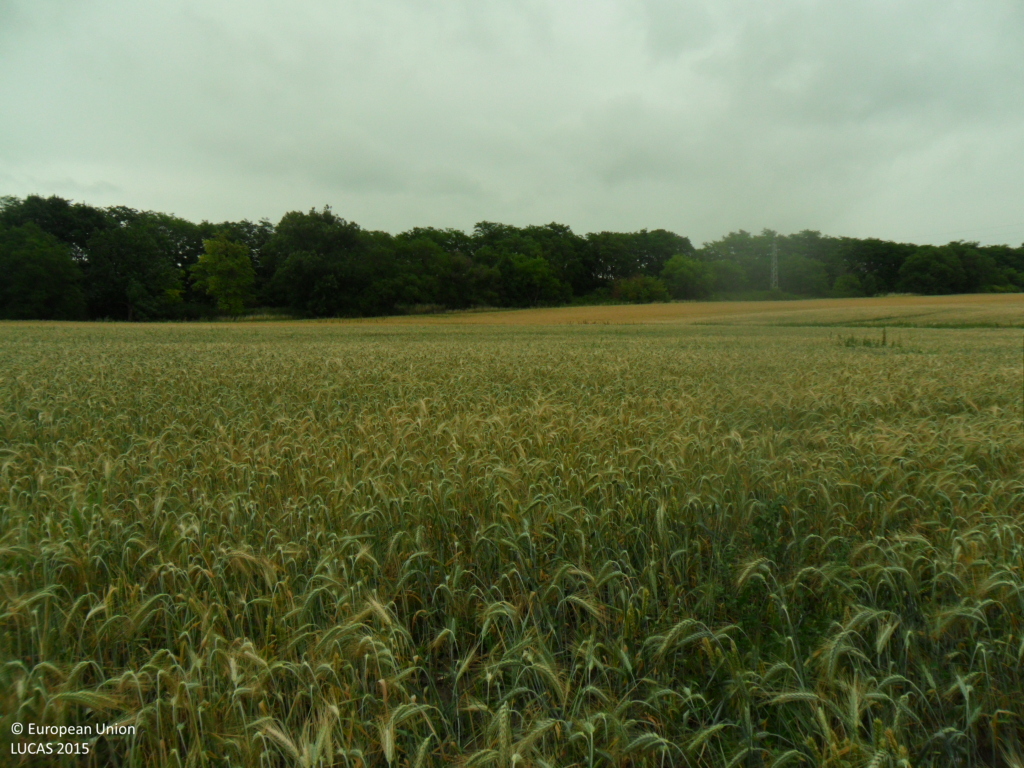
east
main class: Cropland
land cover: Common wheat
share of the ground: > 75 %
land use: Agriculture (excluding fallow land and kitchen gardens)
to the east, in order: Common wheat; Lines of trees; Grass margins; Paved roads, cycling and walking lanes; Grass margins; Broadleaved woodland; Grass margins; Maize
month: June
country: BG
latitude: 43.3438
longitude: 26.9779
